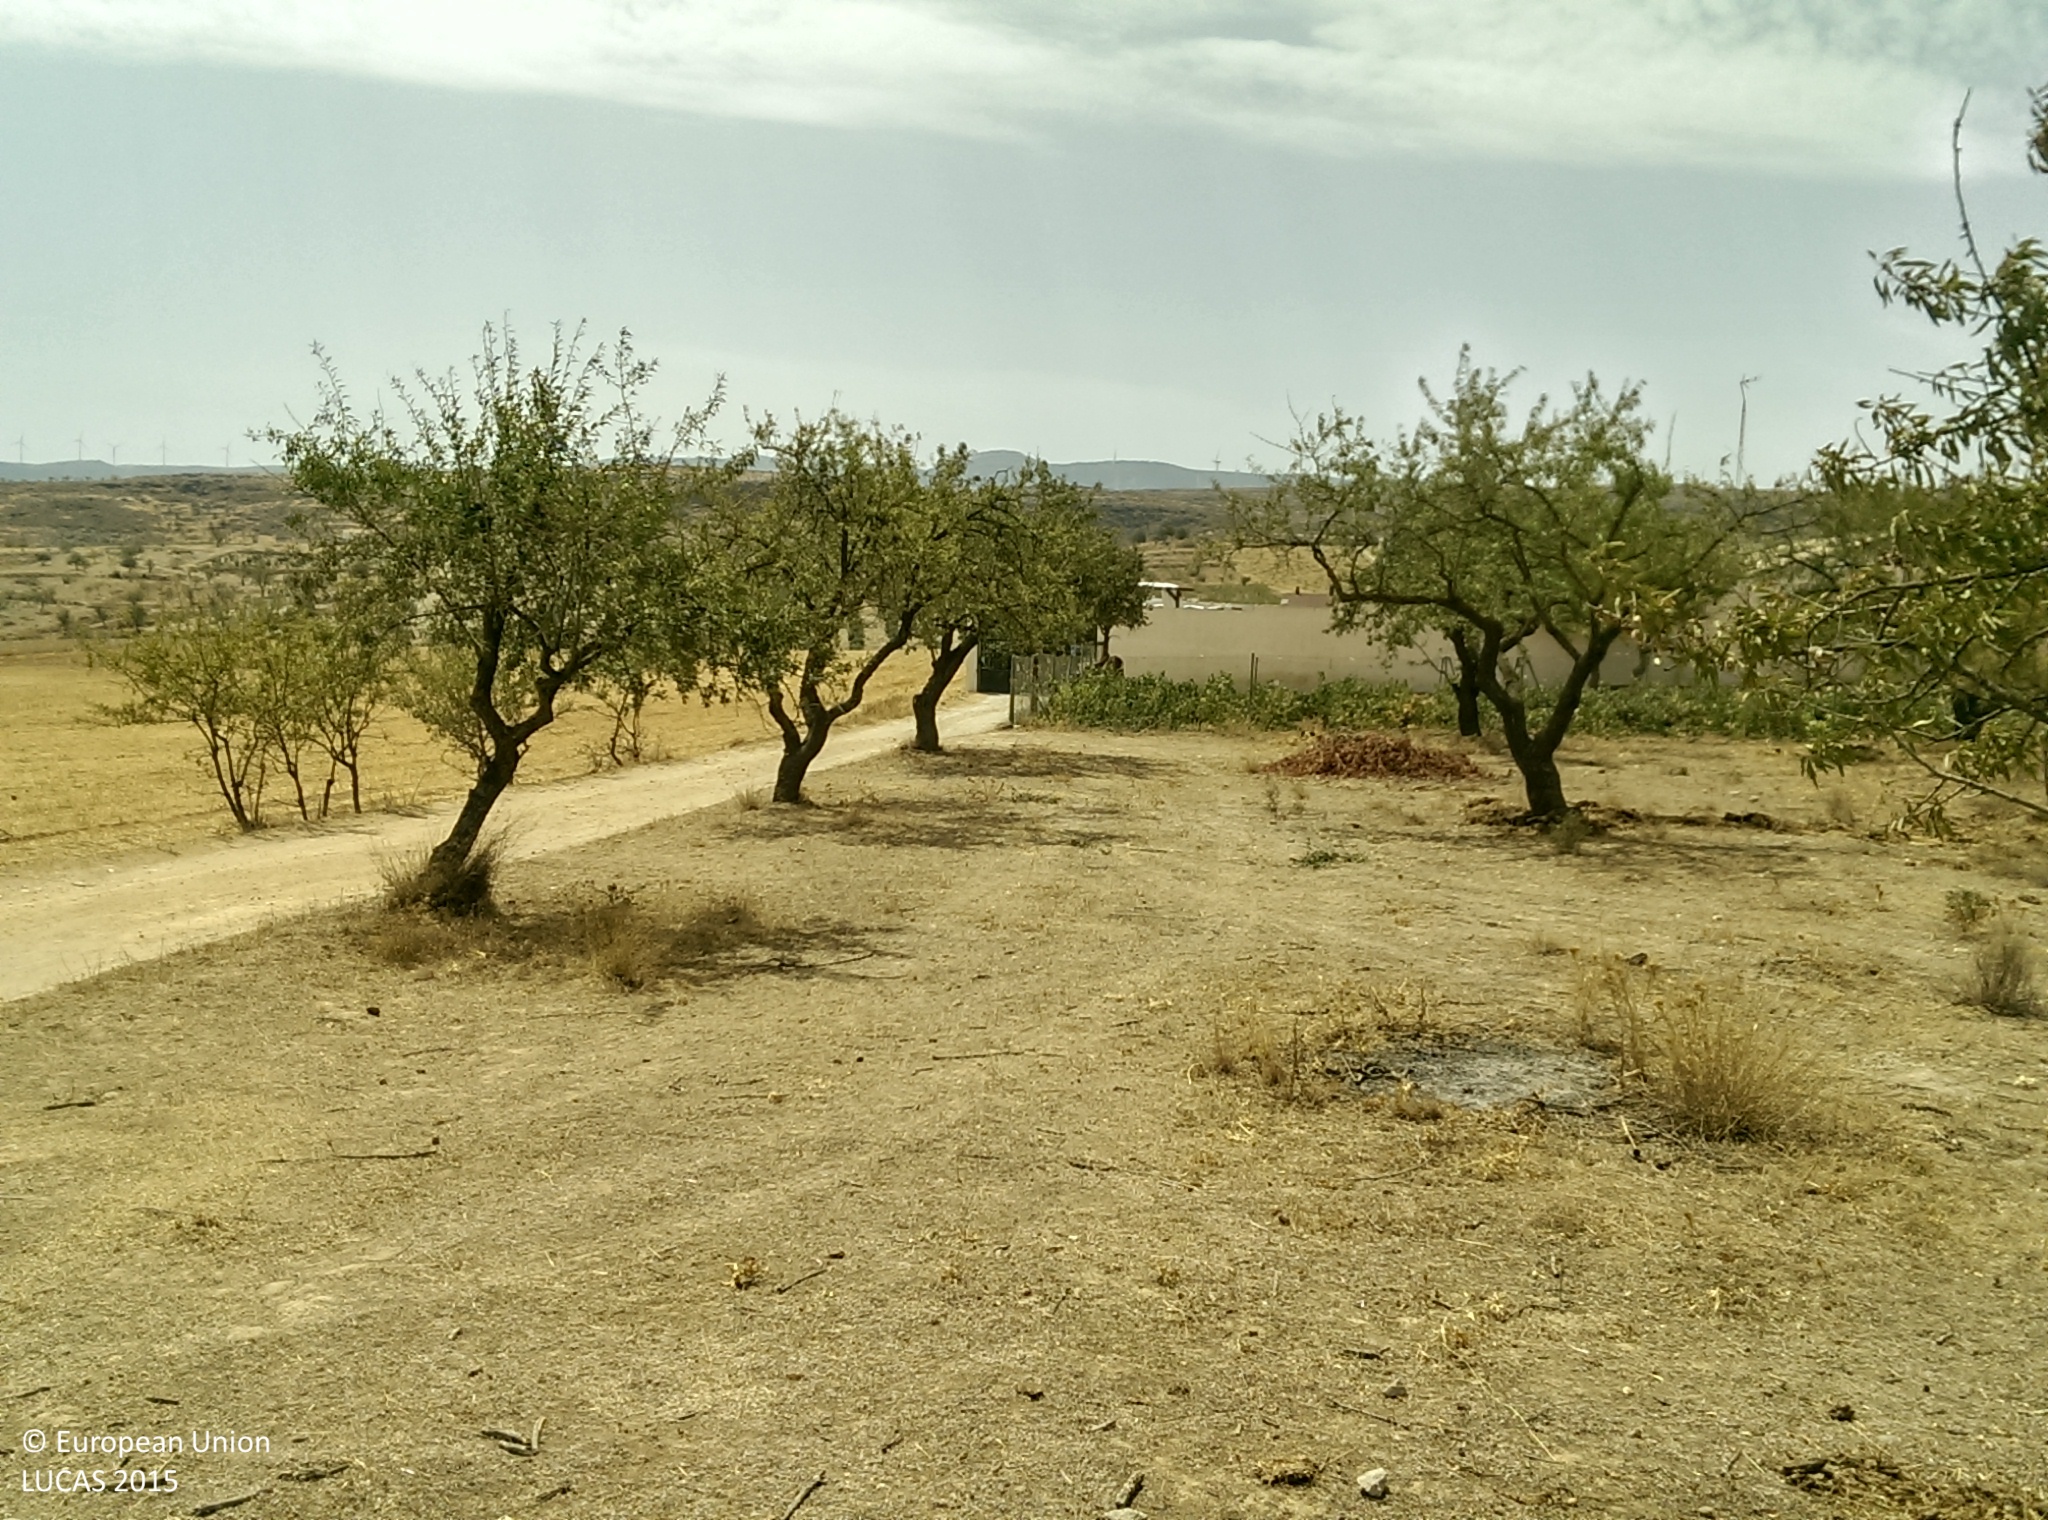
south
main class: Cropland
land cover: Nuts trees
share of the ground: 10 - 25 %
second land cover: Other bare soil
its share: > 75 %
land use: Agriculture (excluding fallow land and kitchen gardens)
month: August
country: ES
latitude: 37.0343
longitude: -3.6464
